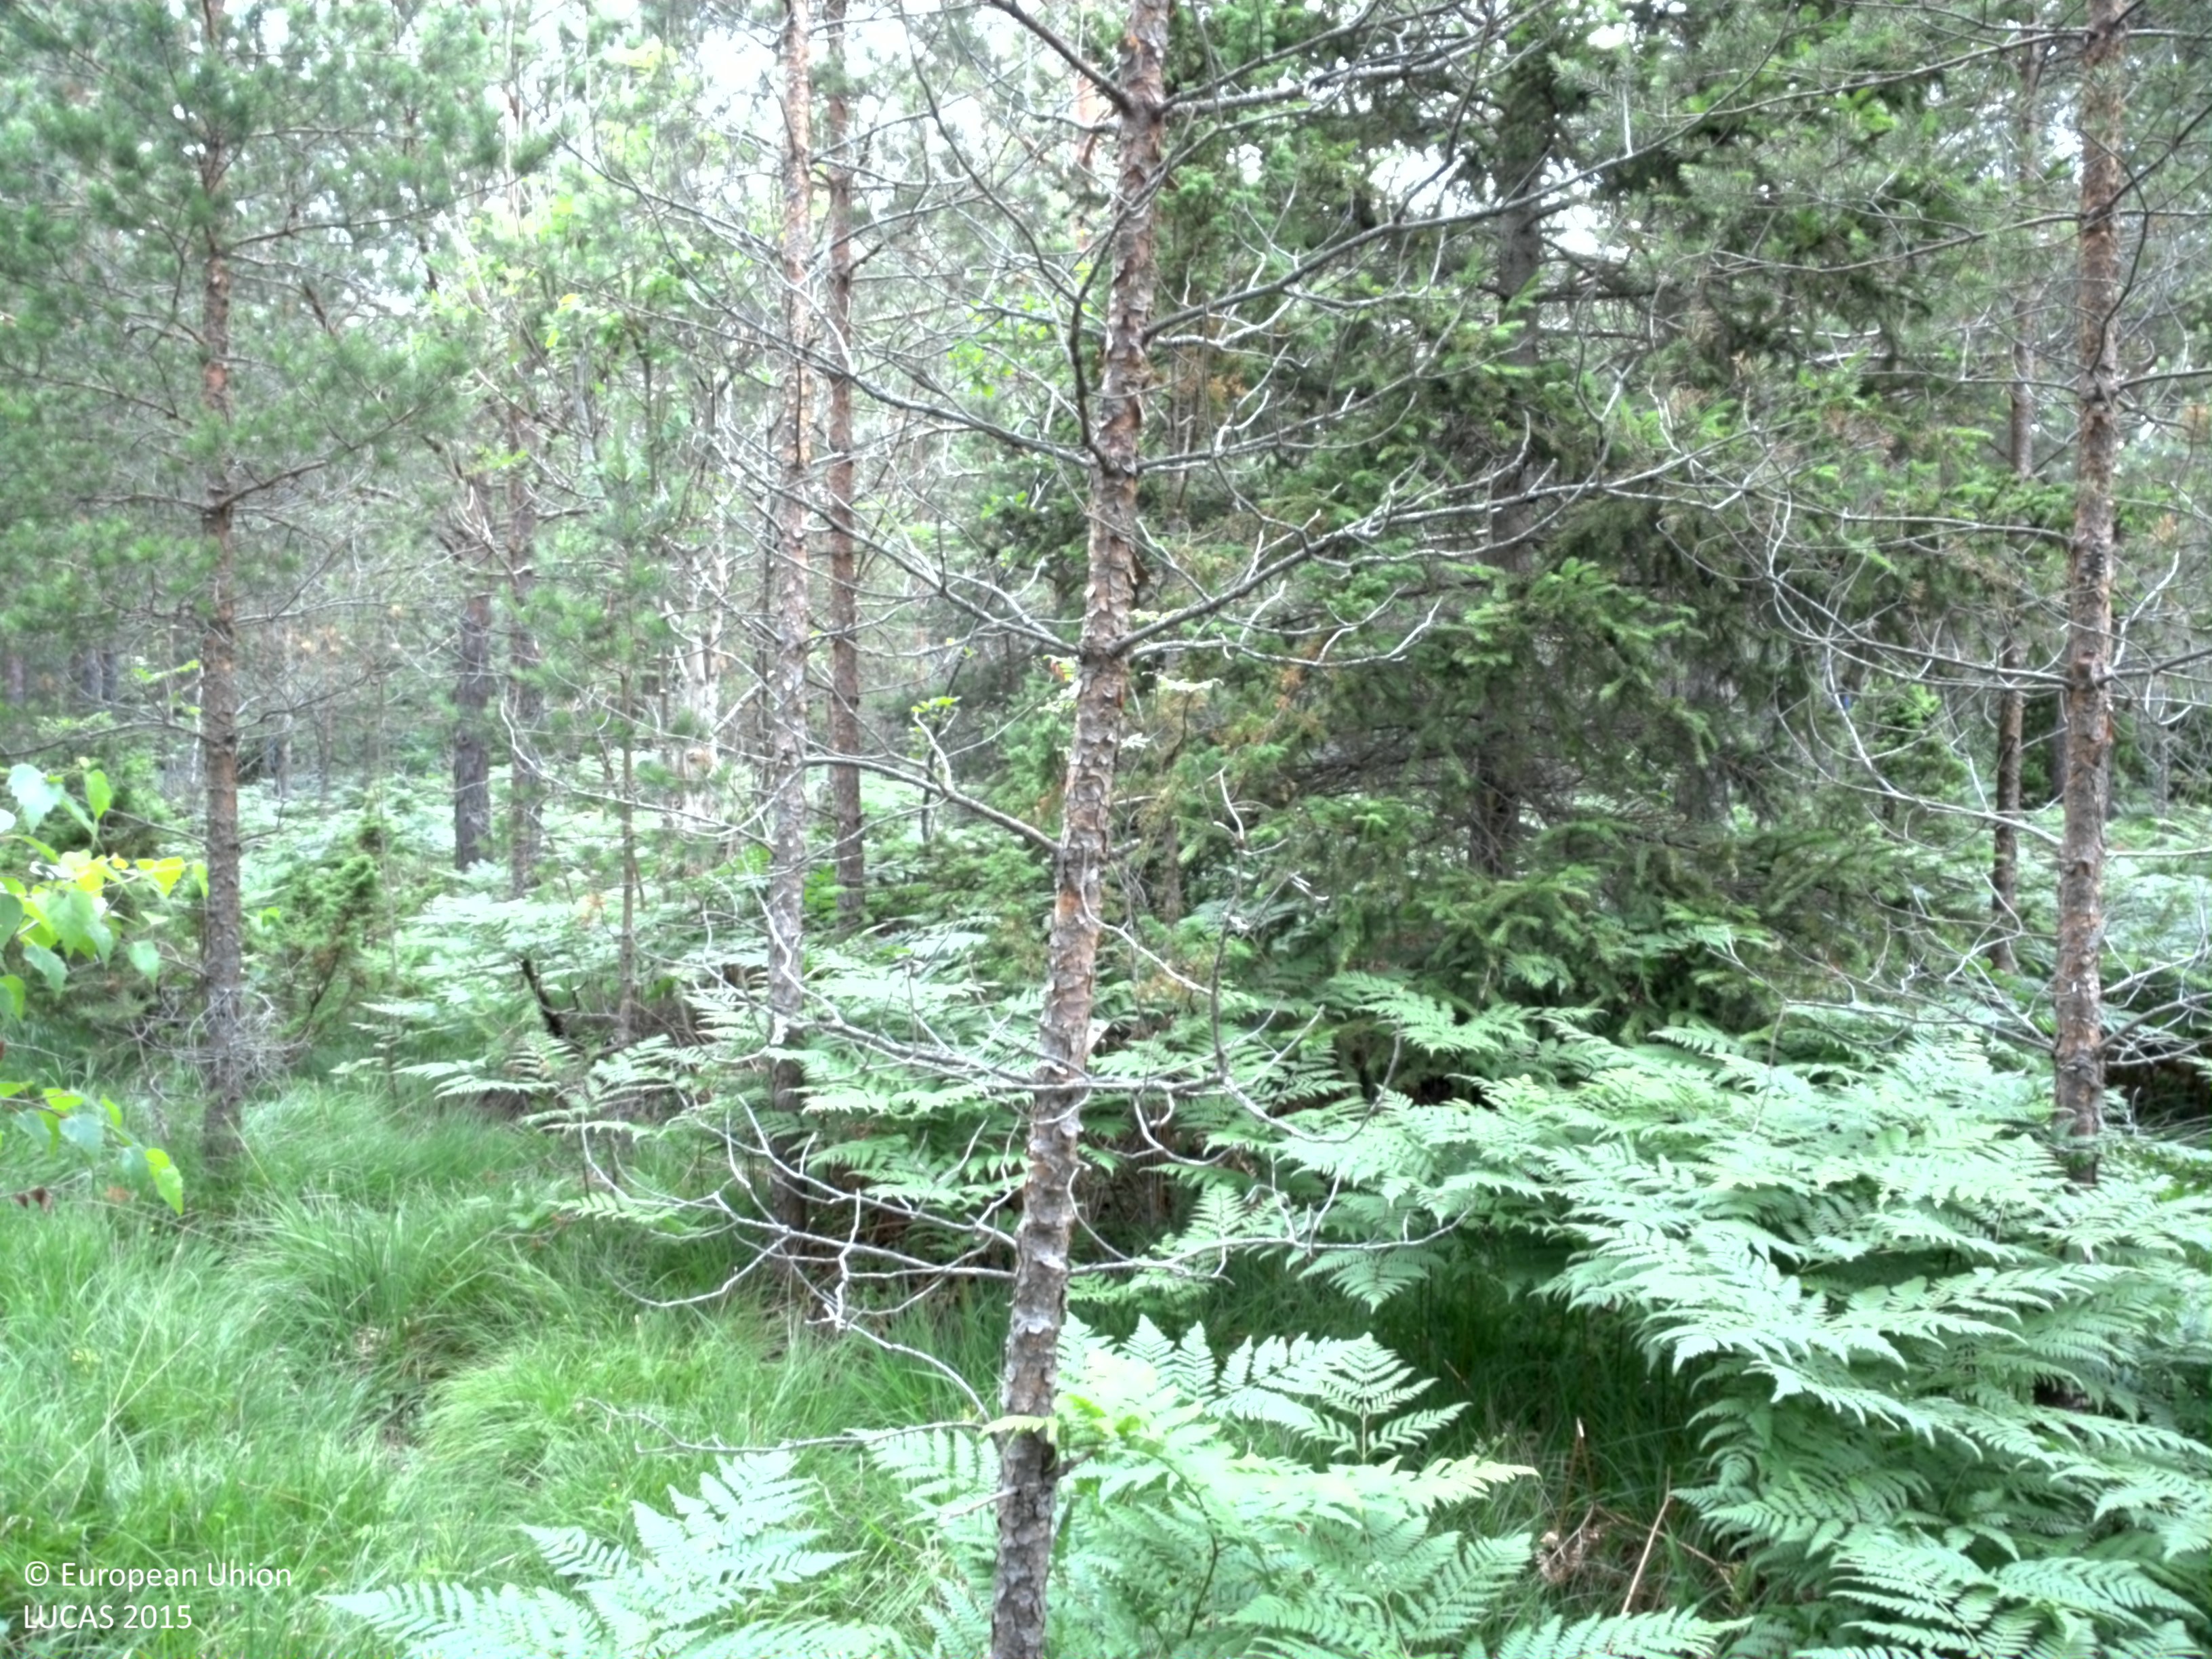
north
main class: Woodland
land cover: Pine dominated coniferous woodland
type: hemiboreal forest and nemoral coniferous forest and mixed broadleaved-coniferous forest
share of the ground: > 75 %
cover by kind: coniferous forest trees 75 %, herbaceous plants 15 %, broadleaved forest trees 5 %, shrubs 5 %
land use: Forestry
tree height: > 5 m
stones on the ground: < 10 %
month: July
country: SE
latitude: 57.3852
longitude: 18.2752
